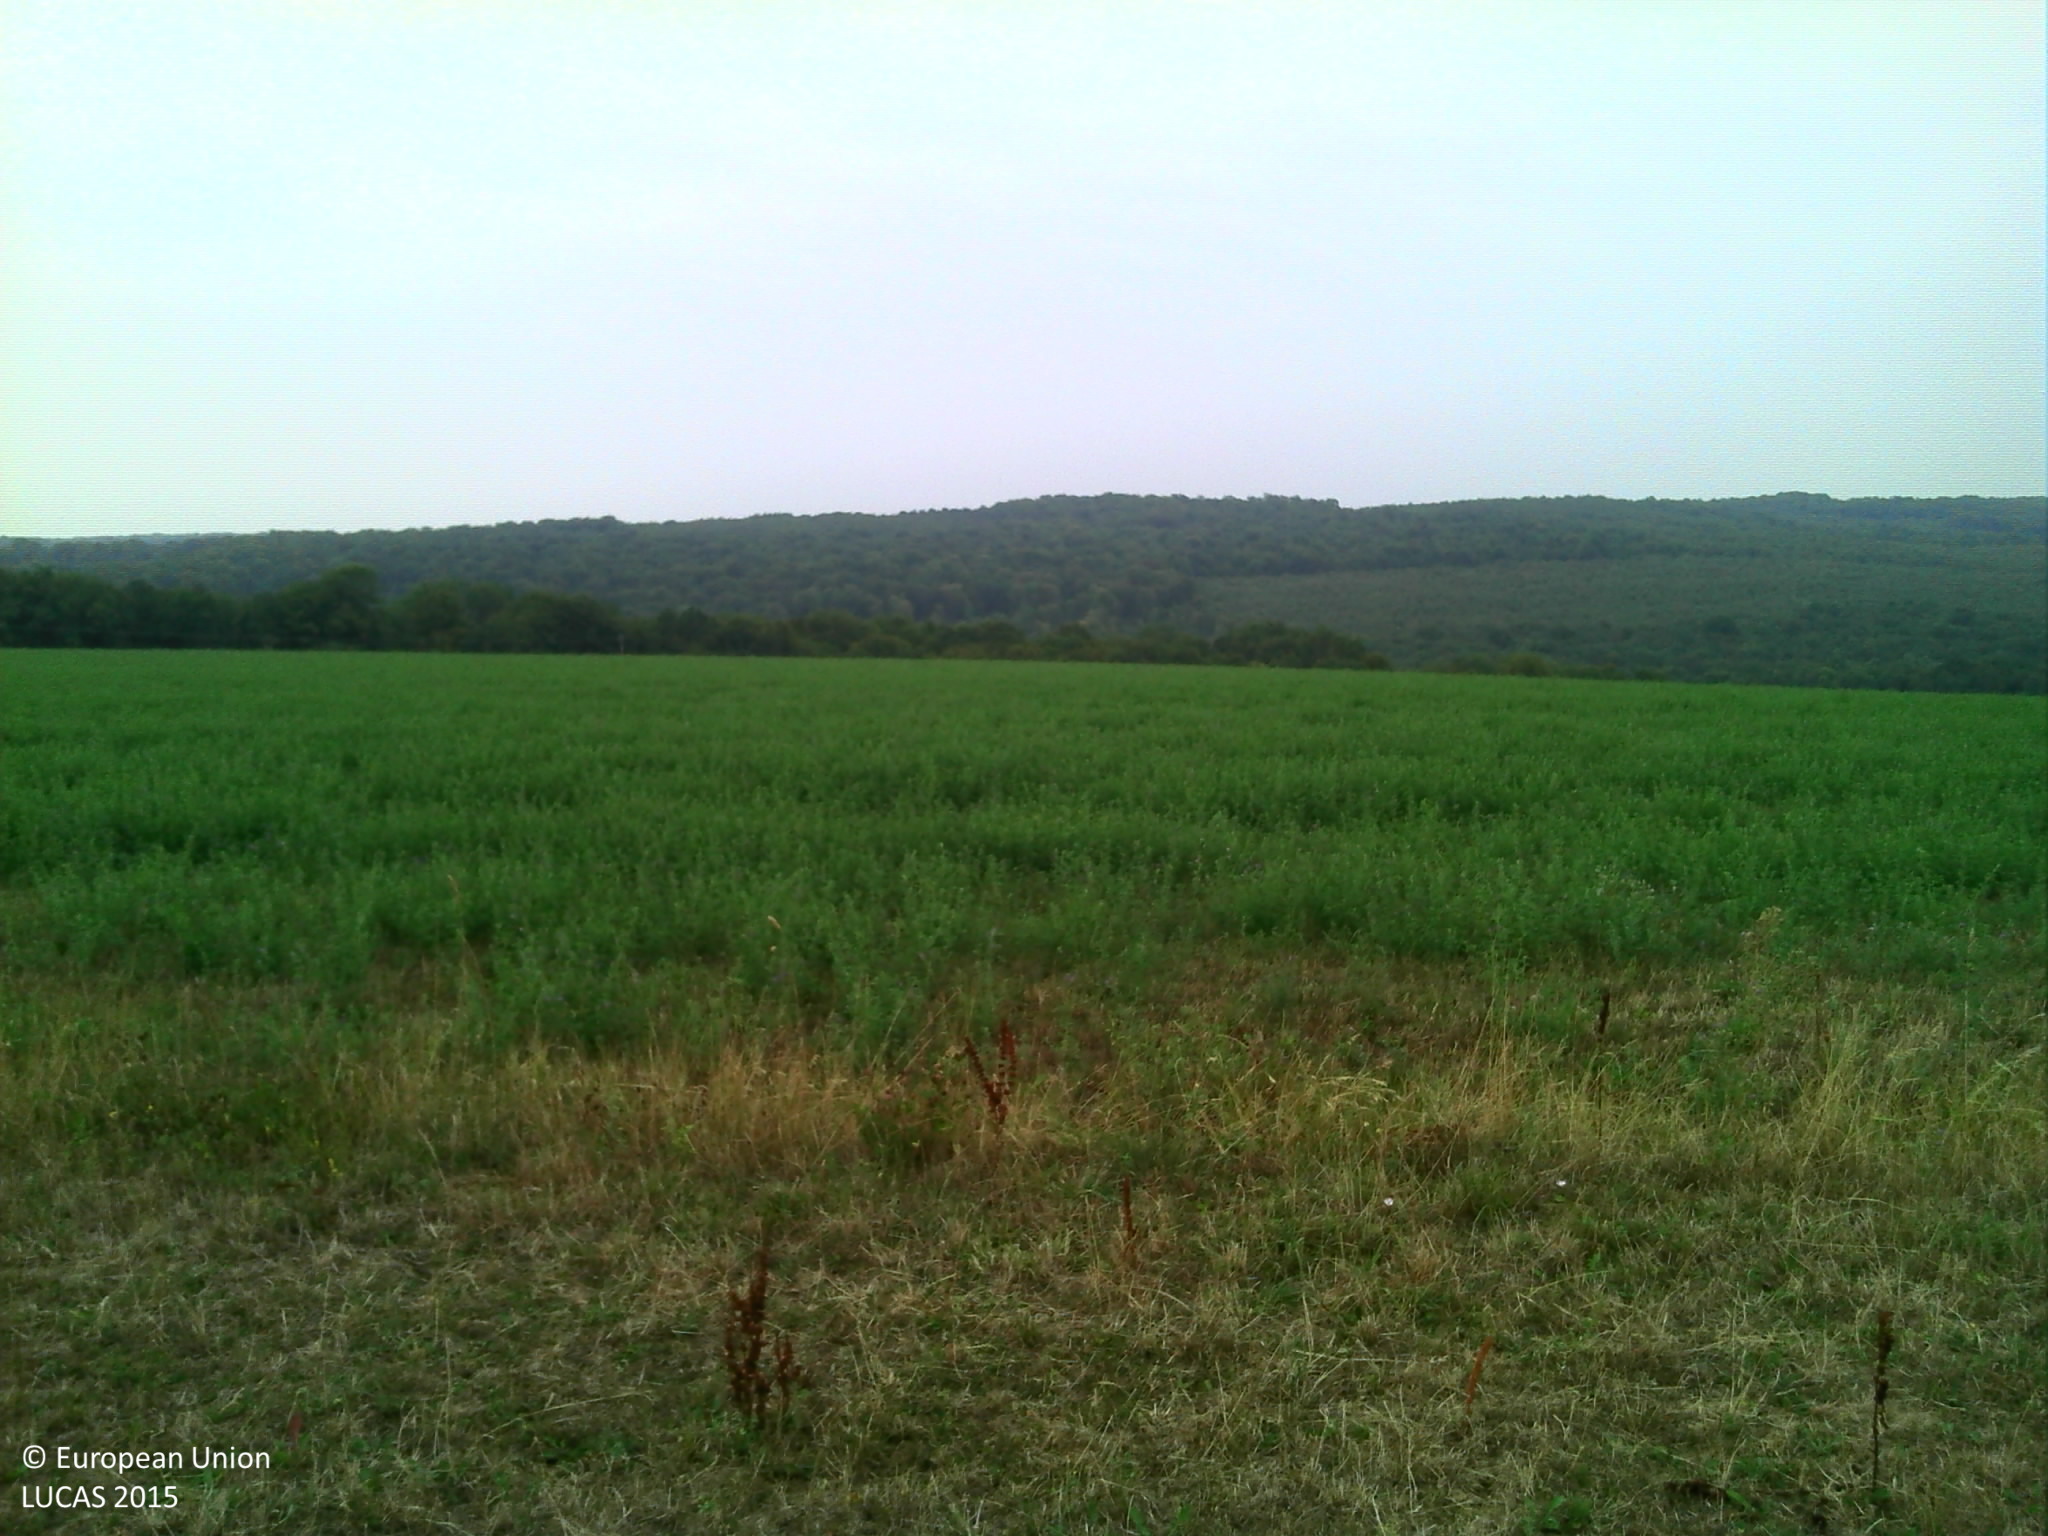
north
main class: Grassland
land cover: Grassland without tree/shrub cover
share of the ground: > 75 %
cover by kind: herbaceous plants 100 %
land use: Agriculture (excluding fallow land and kitchen gardens)
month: August
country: FR
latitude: 49.3478
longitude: 5.2767
